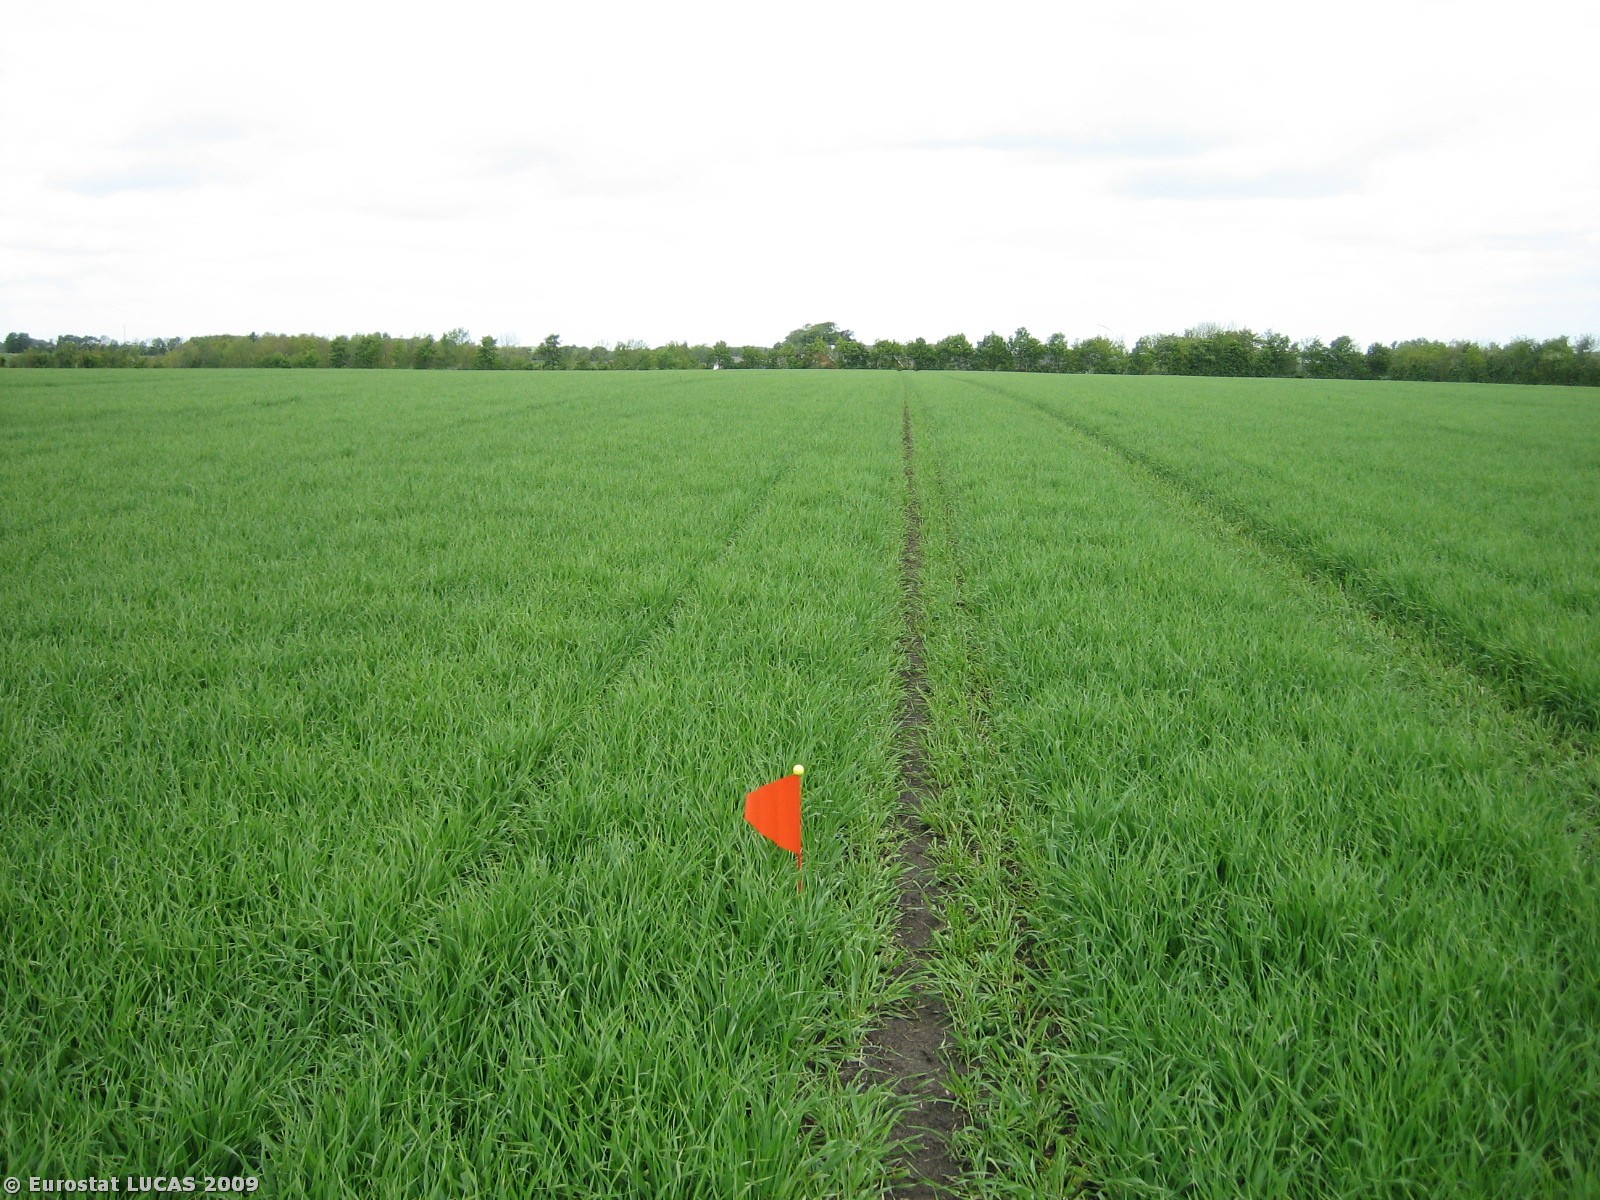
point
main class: Cropland
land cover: Barley
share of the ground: > 75 %
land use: Agriculture (excluding fallow land and kitchen gardens)
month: May
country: DK
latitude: 56.1467
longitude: 8.8585
